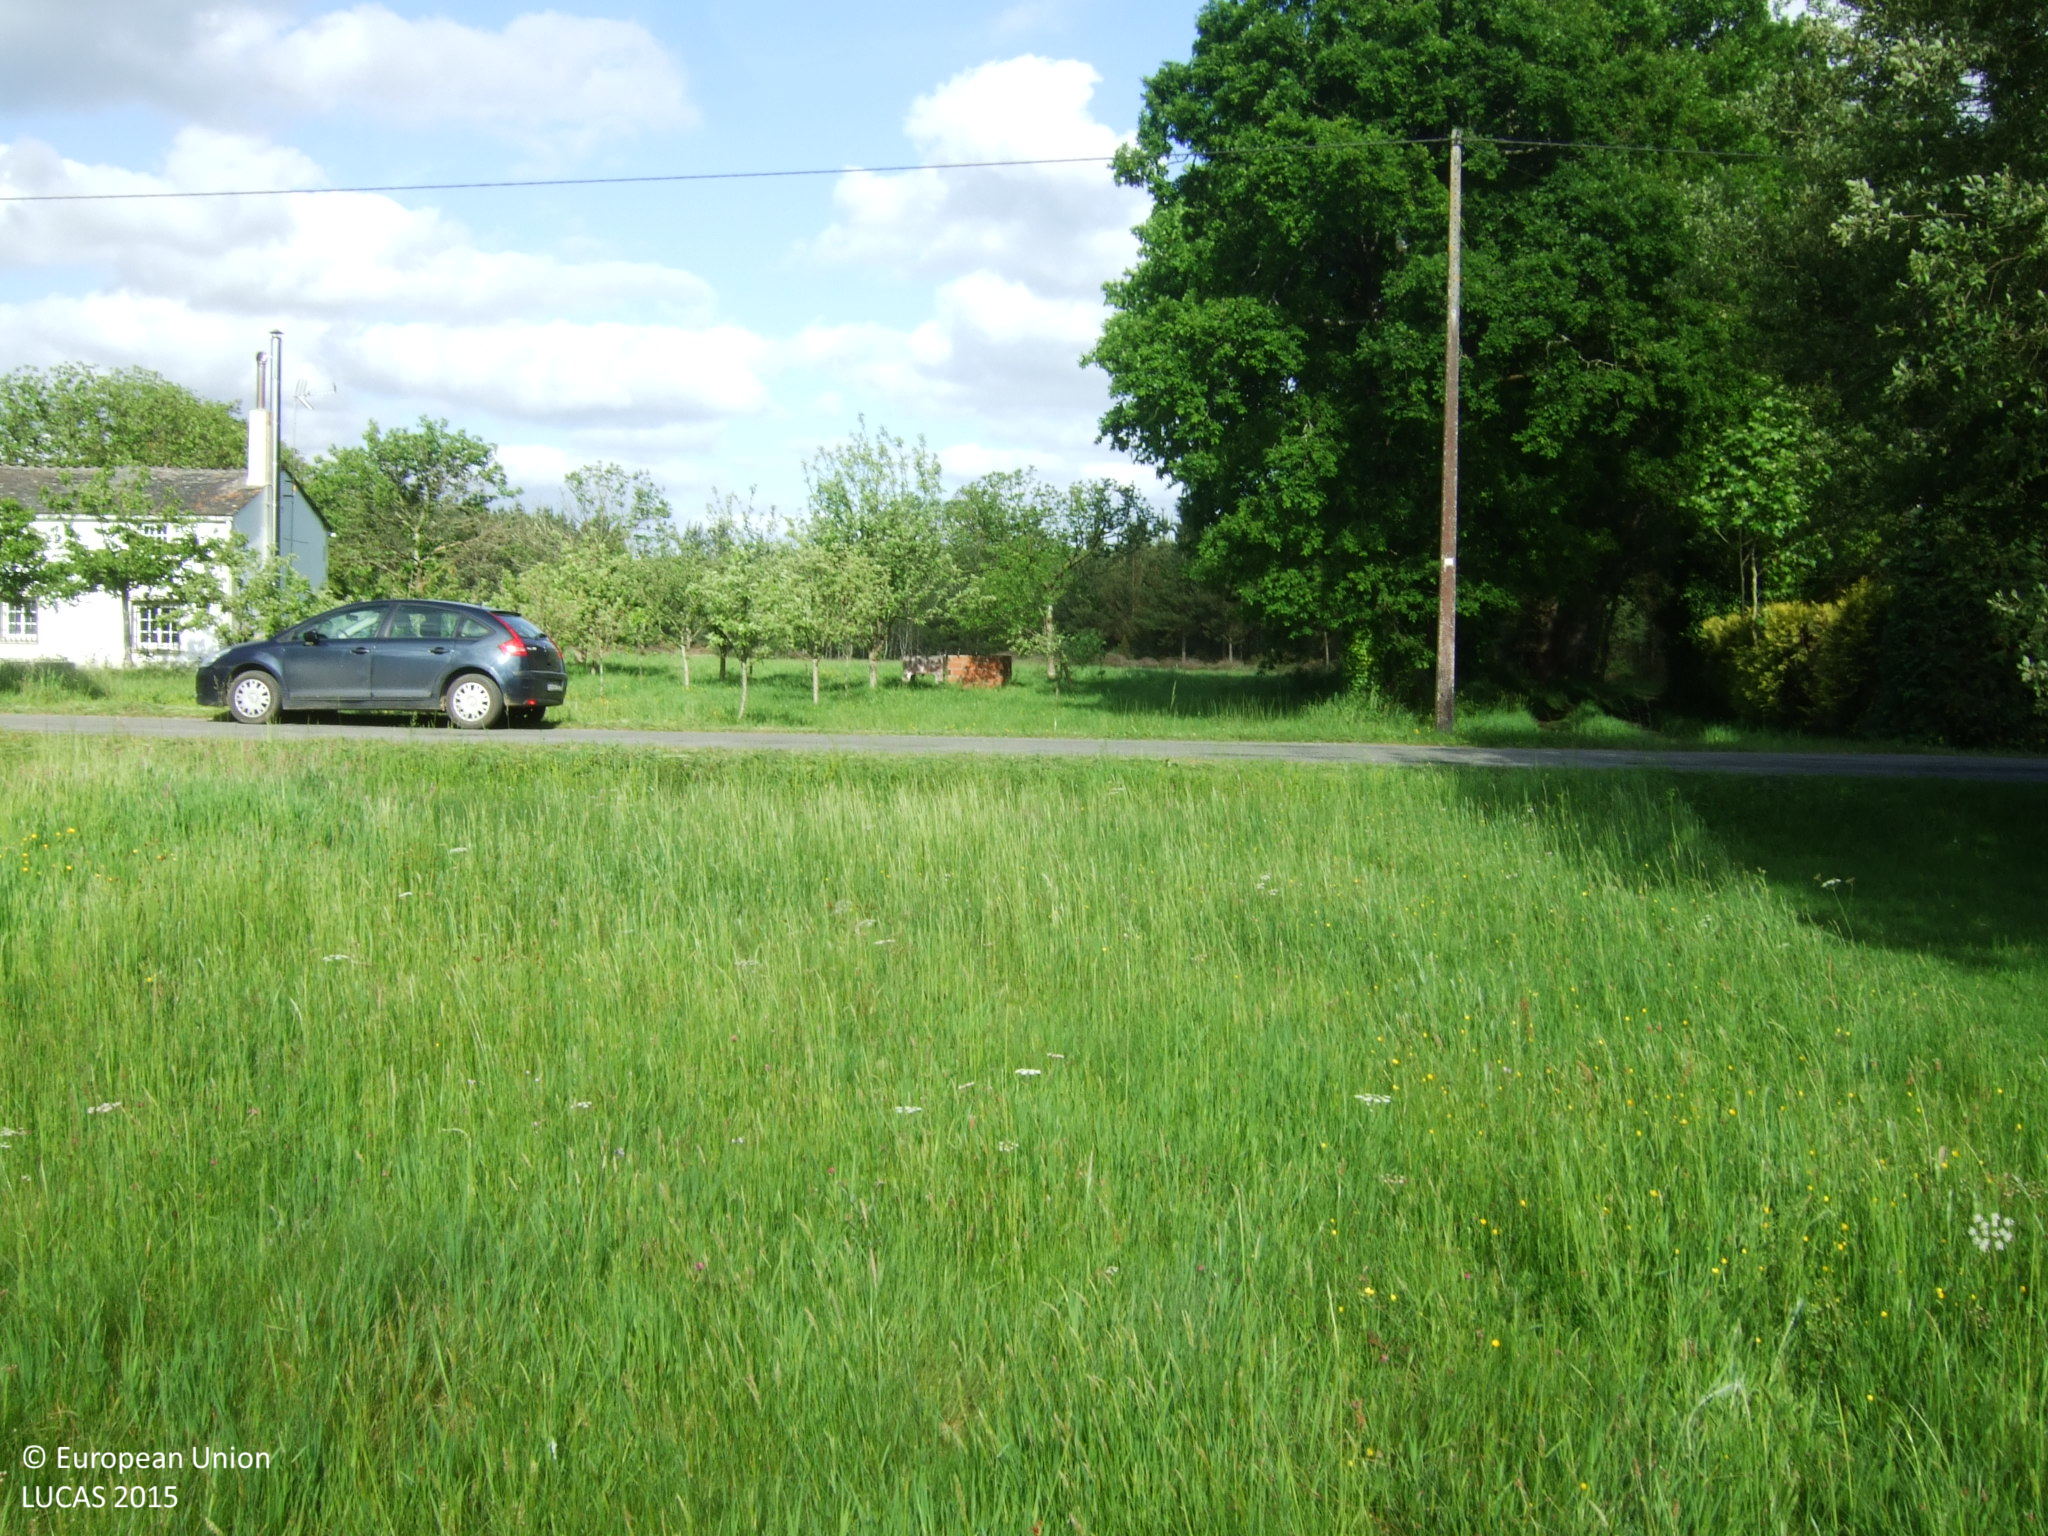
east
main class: Grassland
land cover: Grassland without tree/shrub cover
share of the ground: > 75 %
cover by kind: herbaceous plants 100 %
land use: Agriculture (excluding fallow land and kitchen gardens)
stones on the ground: < 10 %
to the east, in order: Grassland without tree/shrub cover; Paved roads, cycling and walking lanes; Apple fruit; Grassland without tree/shrub cover; Shruby margins; Ditches and canals; Tracks; Ditches and canals; Pine dominated coniferous woodland; Broadleaved woodland
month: May
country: ES
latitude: 43.1873
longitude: -7.4626
